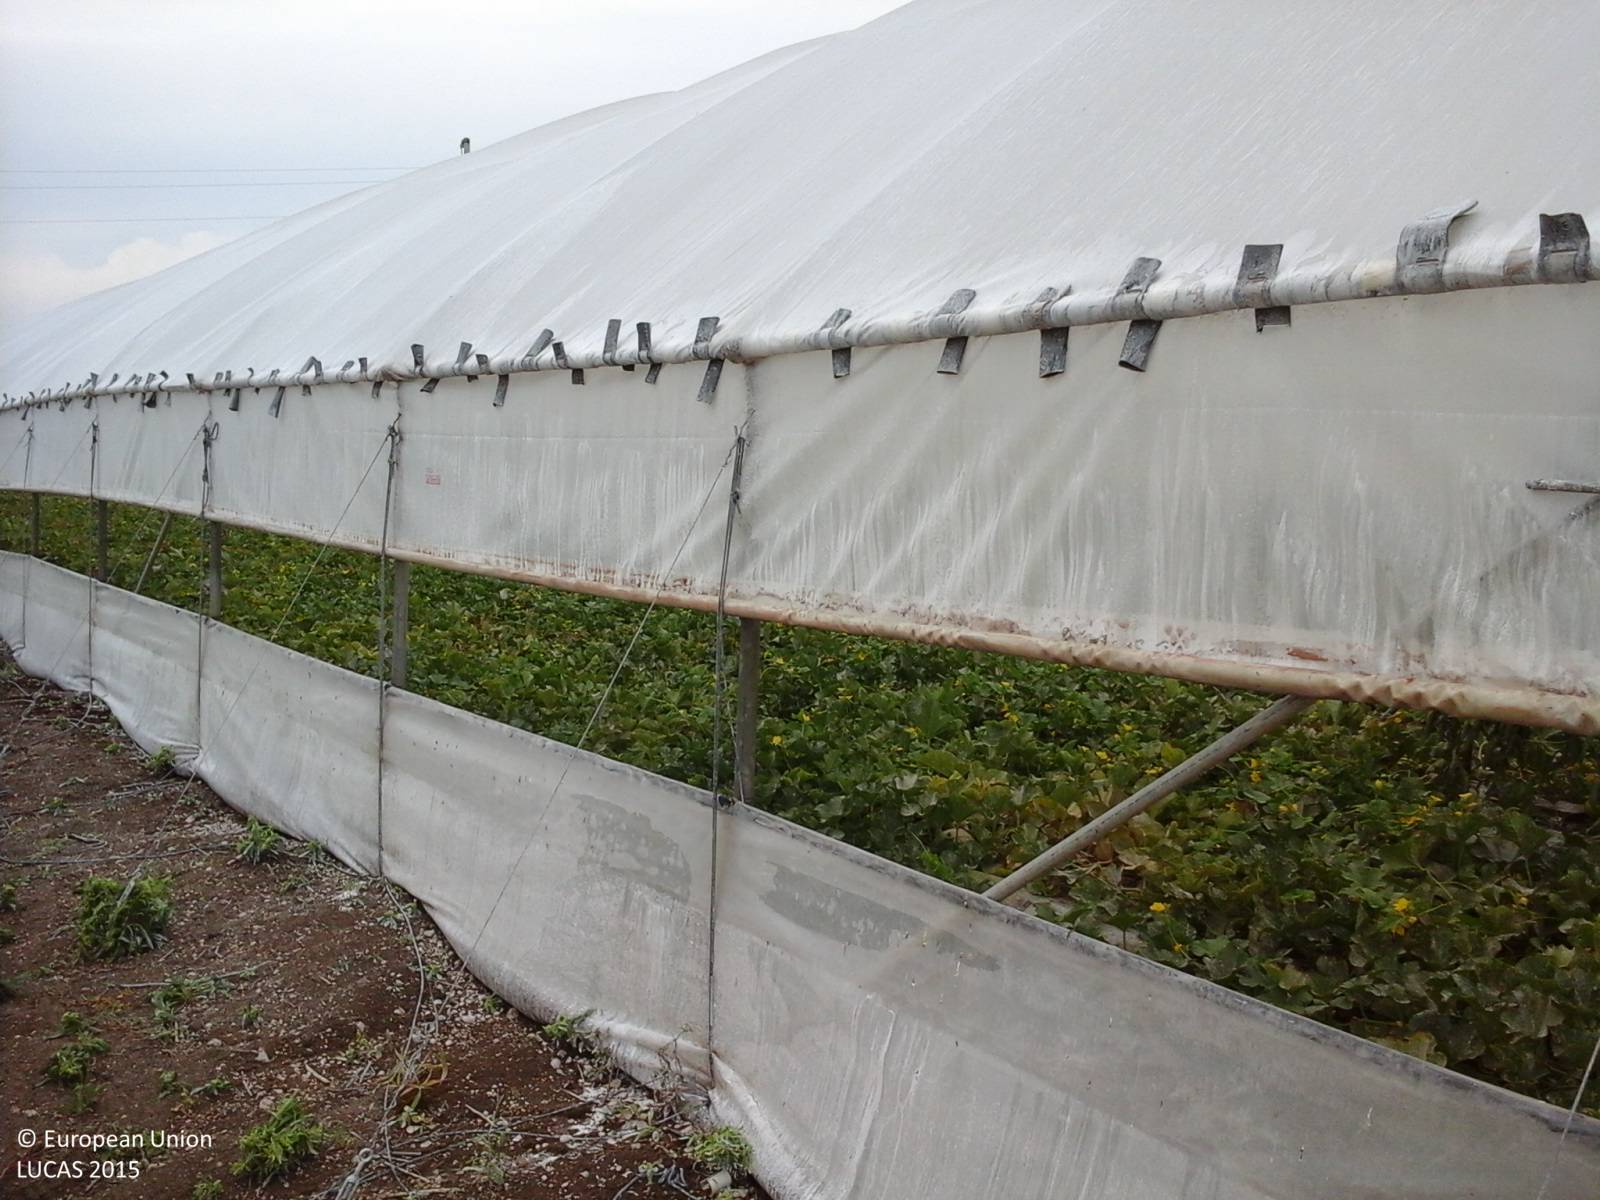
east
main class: Cropland
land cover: Durum wheat
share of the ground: > 75 %
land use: Agriculture (excluding fallow land and kitchen gardens)
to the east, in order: Durum wheat; Artificial constructions in urban areas; Grass margins; Ditches and canals; Paved roads, cycling and walking lanes; Grass margins; Ditches and canals; Electric lines; Oats; Durum wheat
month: June
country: IT
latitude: 42.3905
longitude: 11.4647
